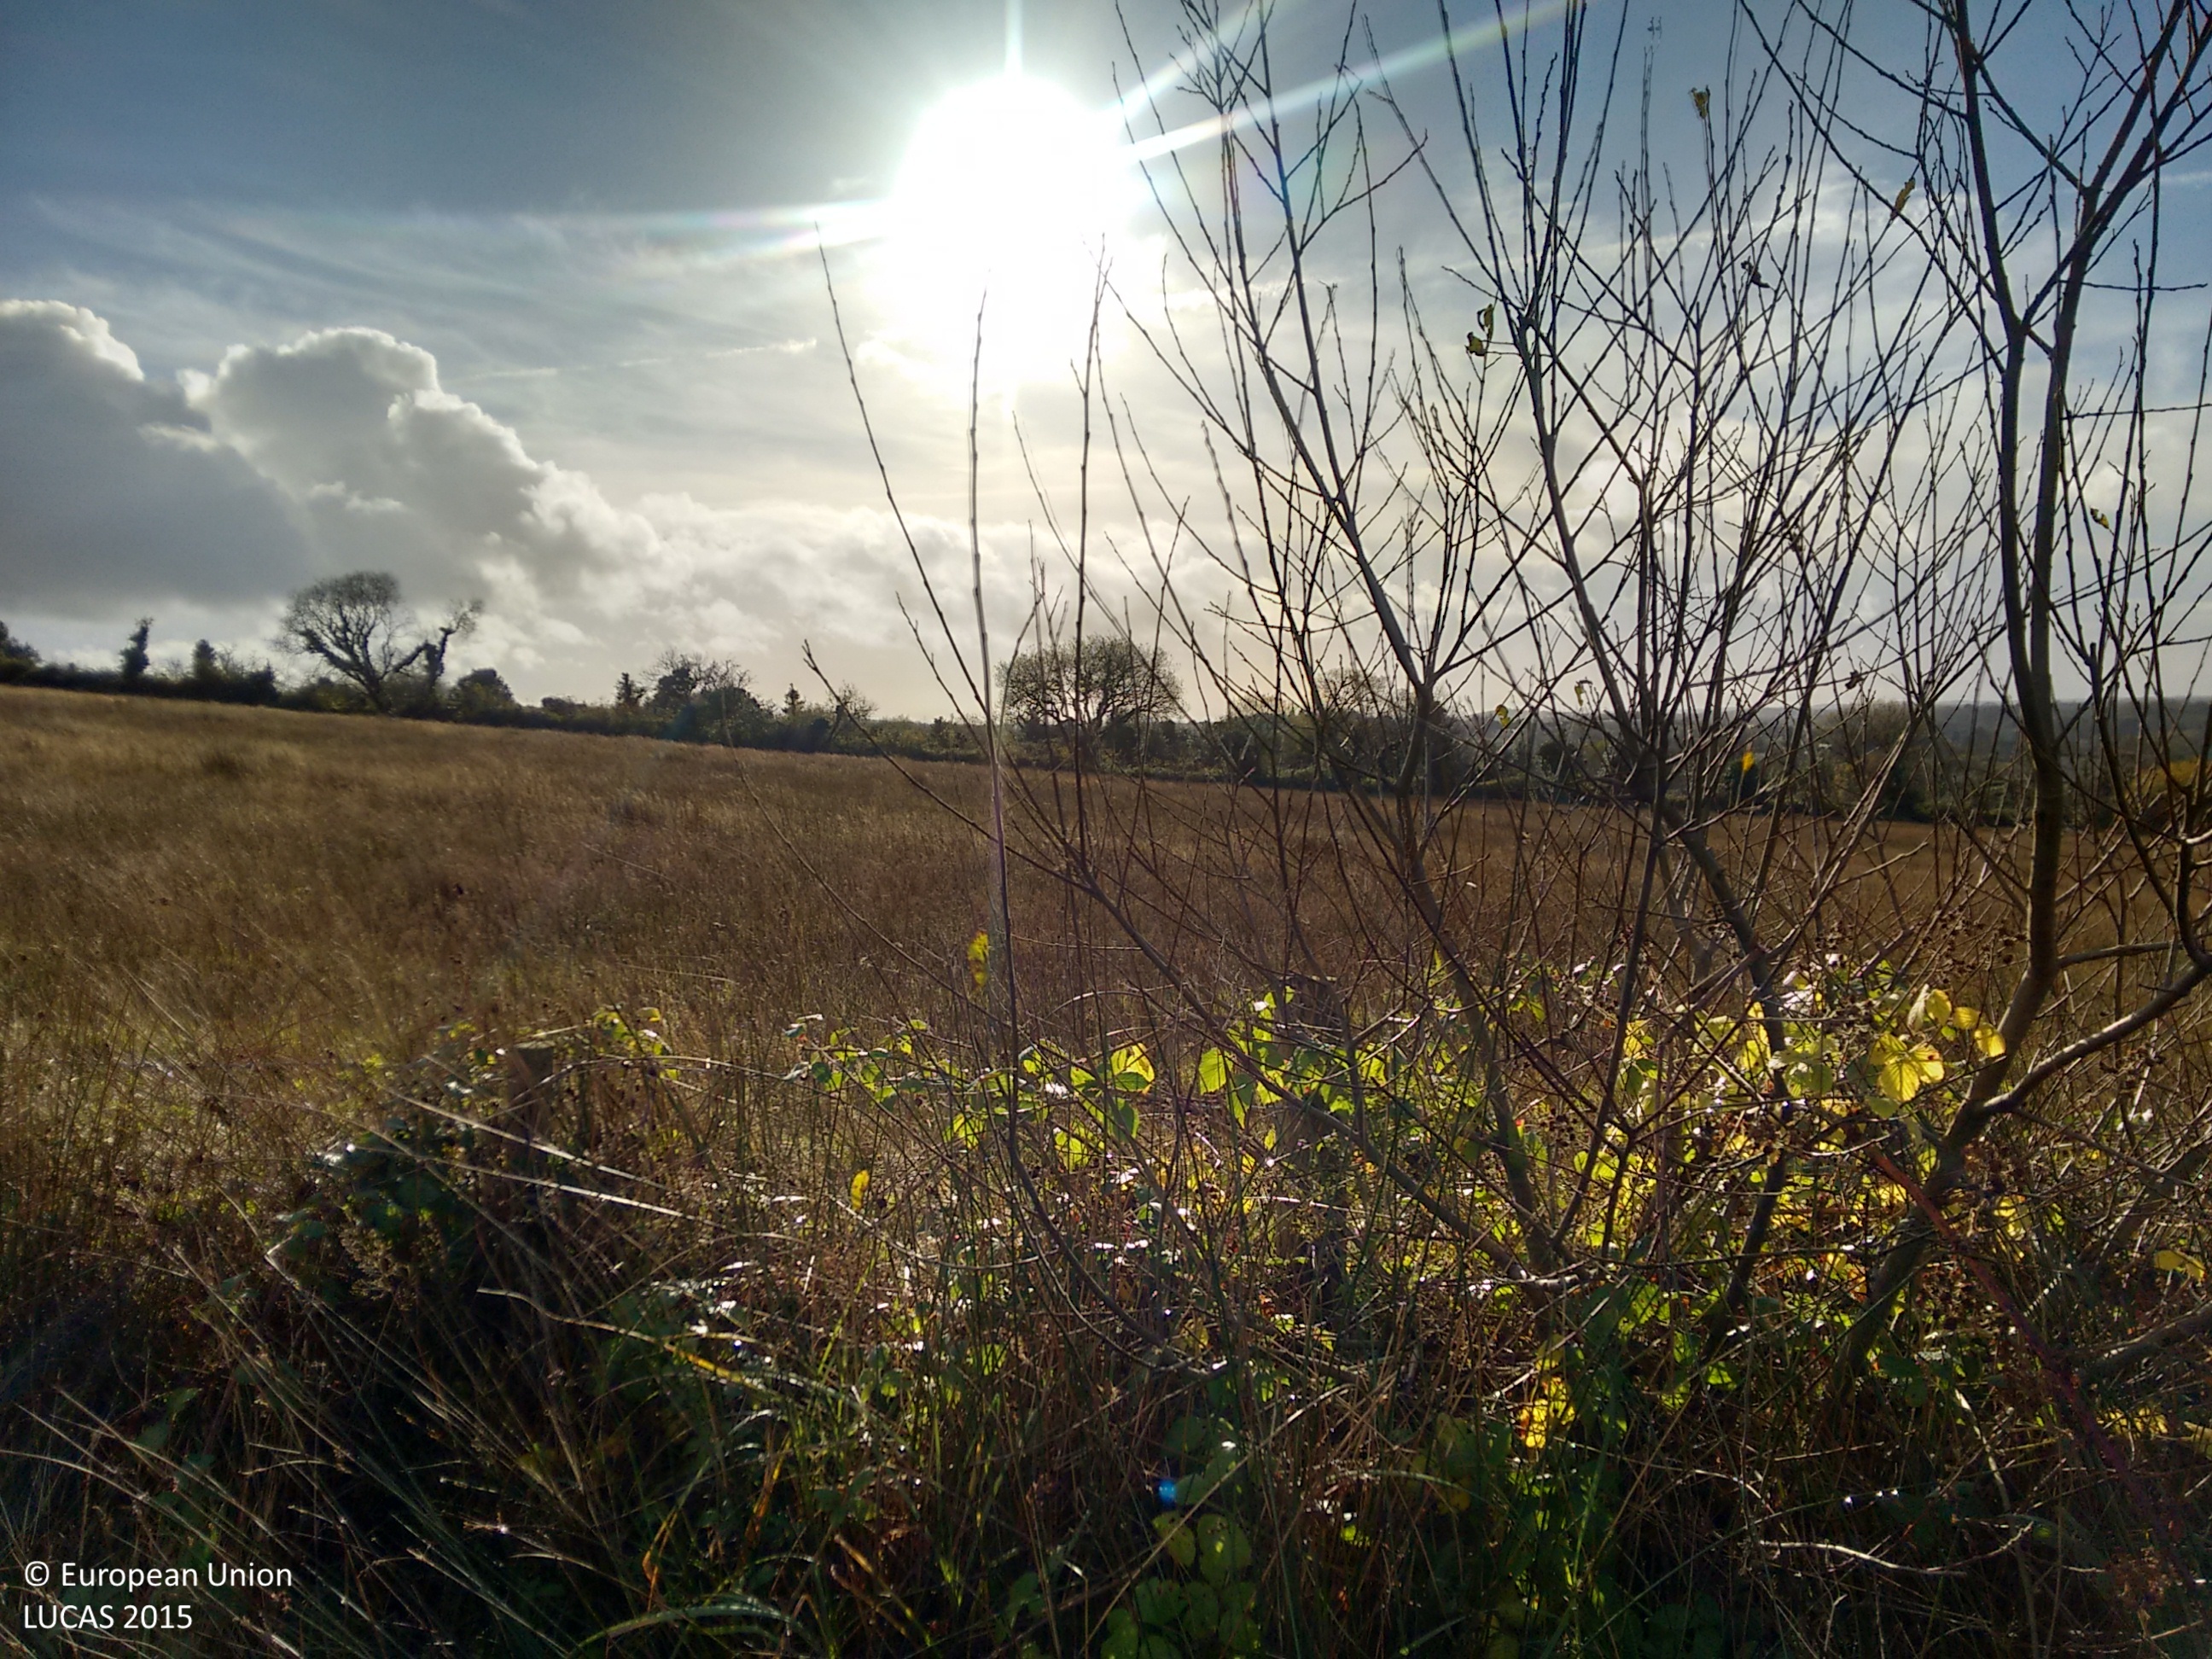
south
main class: Grassland
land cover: Grassland without tree/shrub cover
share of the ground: > 75 %
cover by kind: herbaceous plants 100 %
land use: Agriculture (excluding fallow land and kitchen gardens)
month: November
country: IE
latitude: 54.0615
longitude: -8.0355
